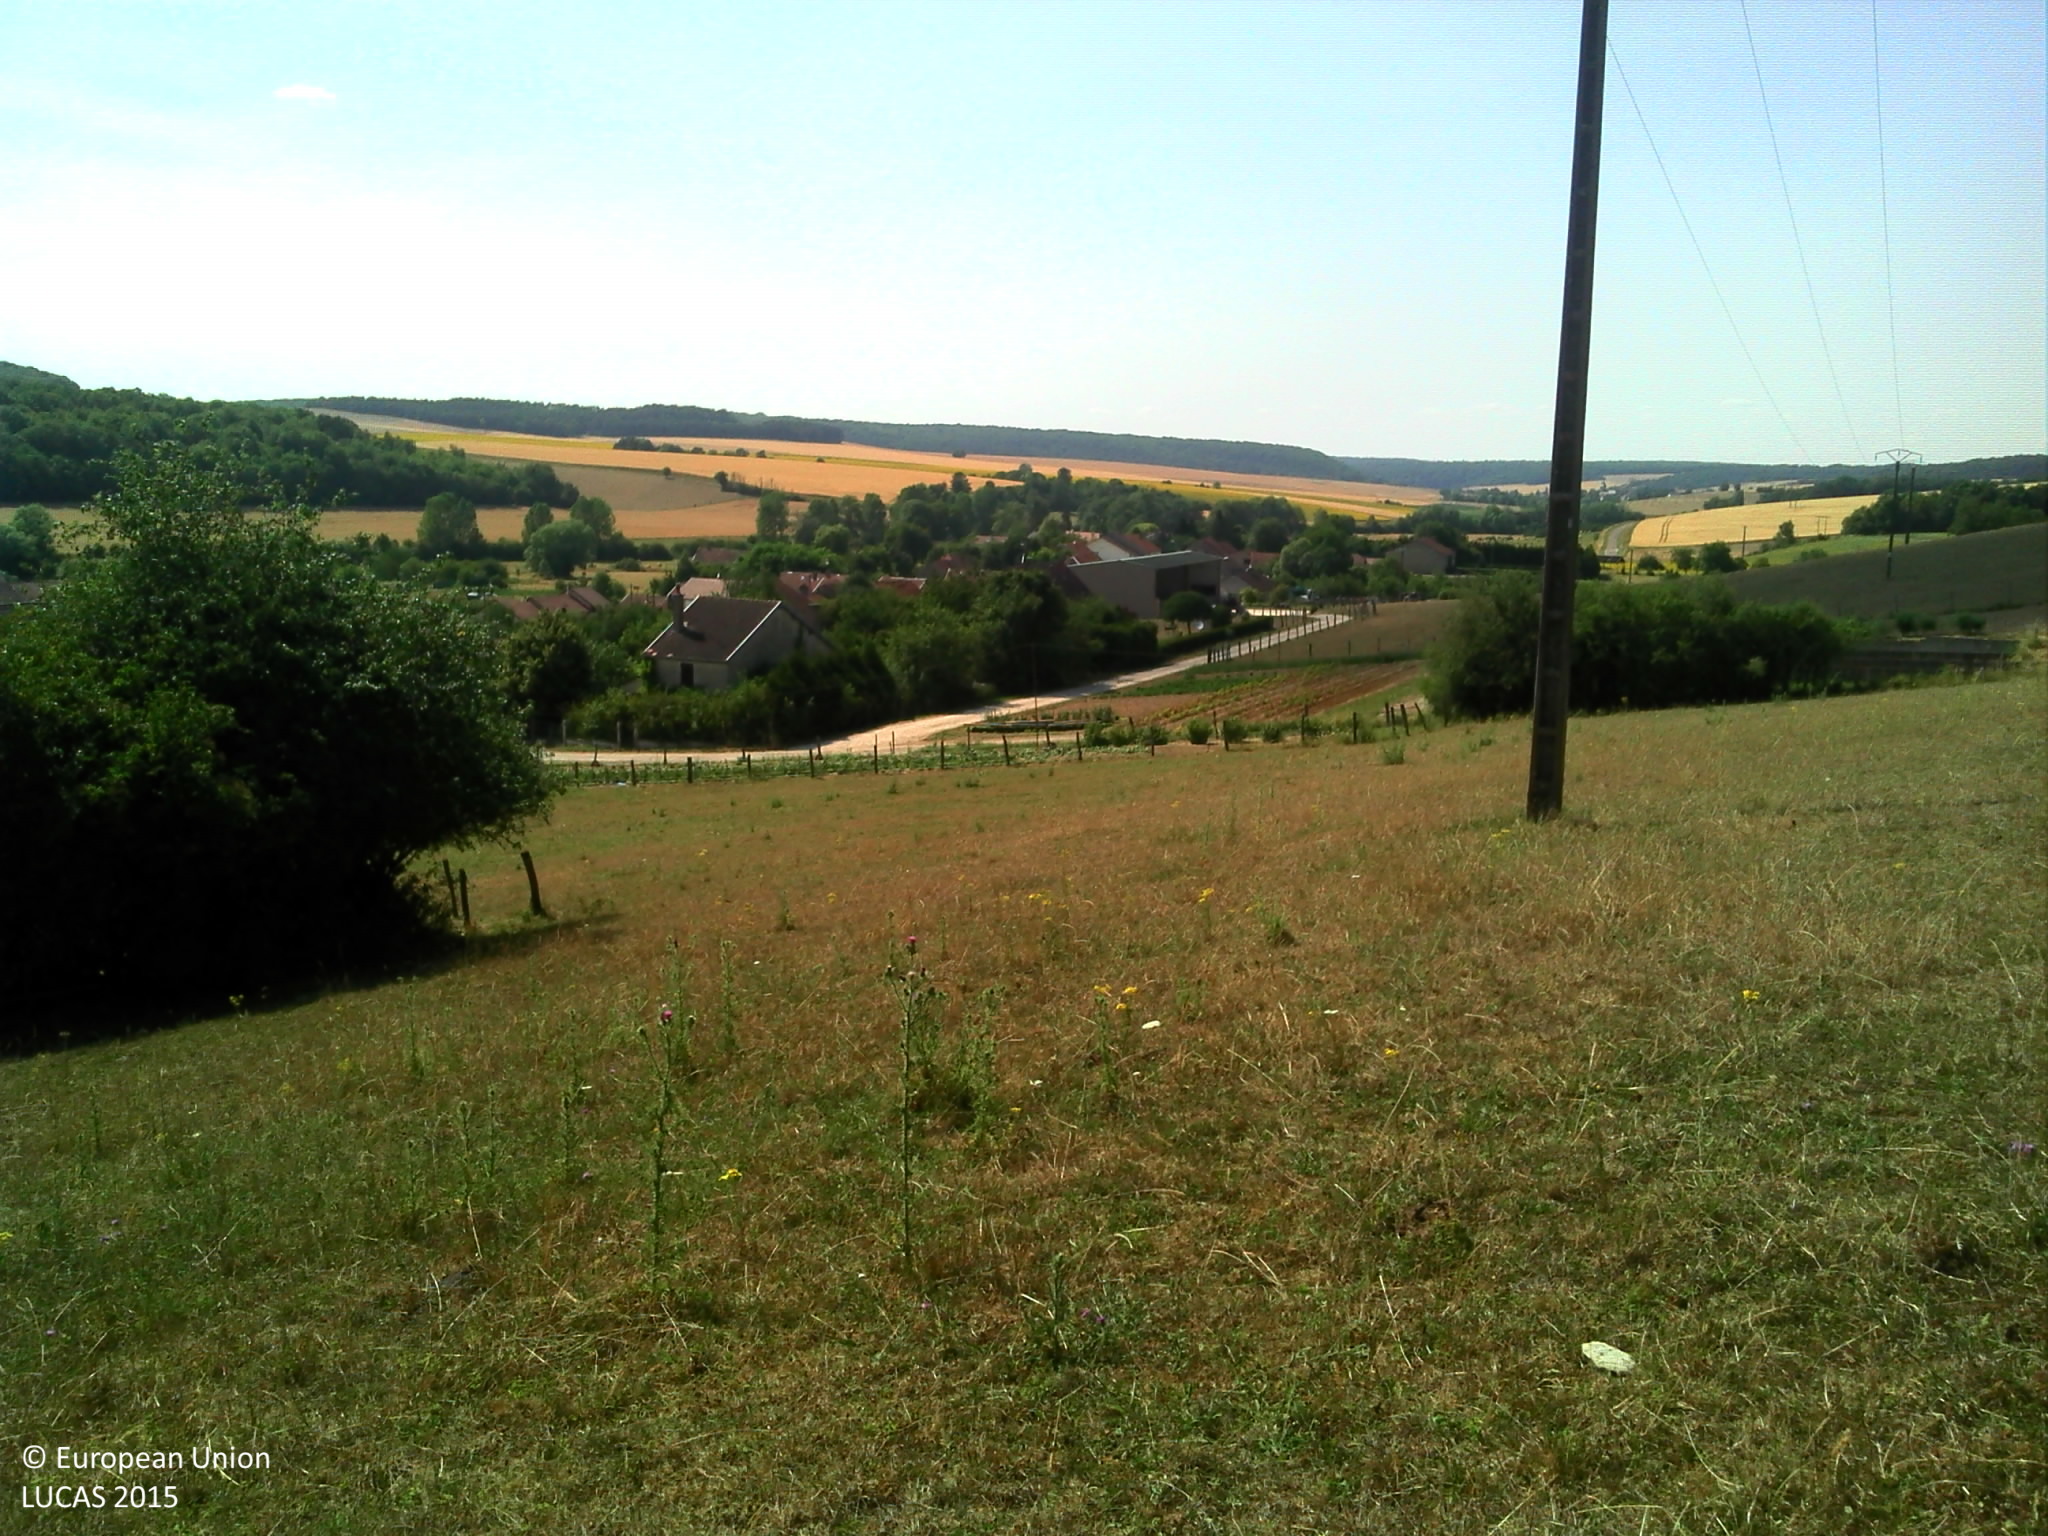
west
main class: Grassland
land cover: Grassland without tree/shrub cover
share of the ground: > 75 %
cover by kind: herbaceous plants 100 %
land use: Agriculture (excluding fallow land and kitchen gardens)
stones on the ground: < 10 %
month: July
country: FR
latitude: 48.1443
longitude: 4.9588
